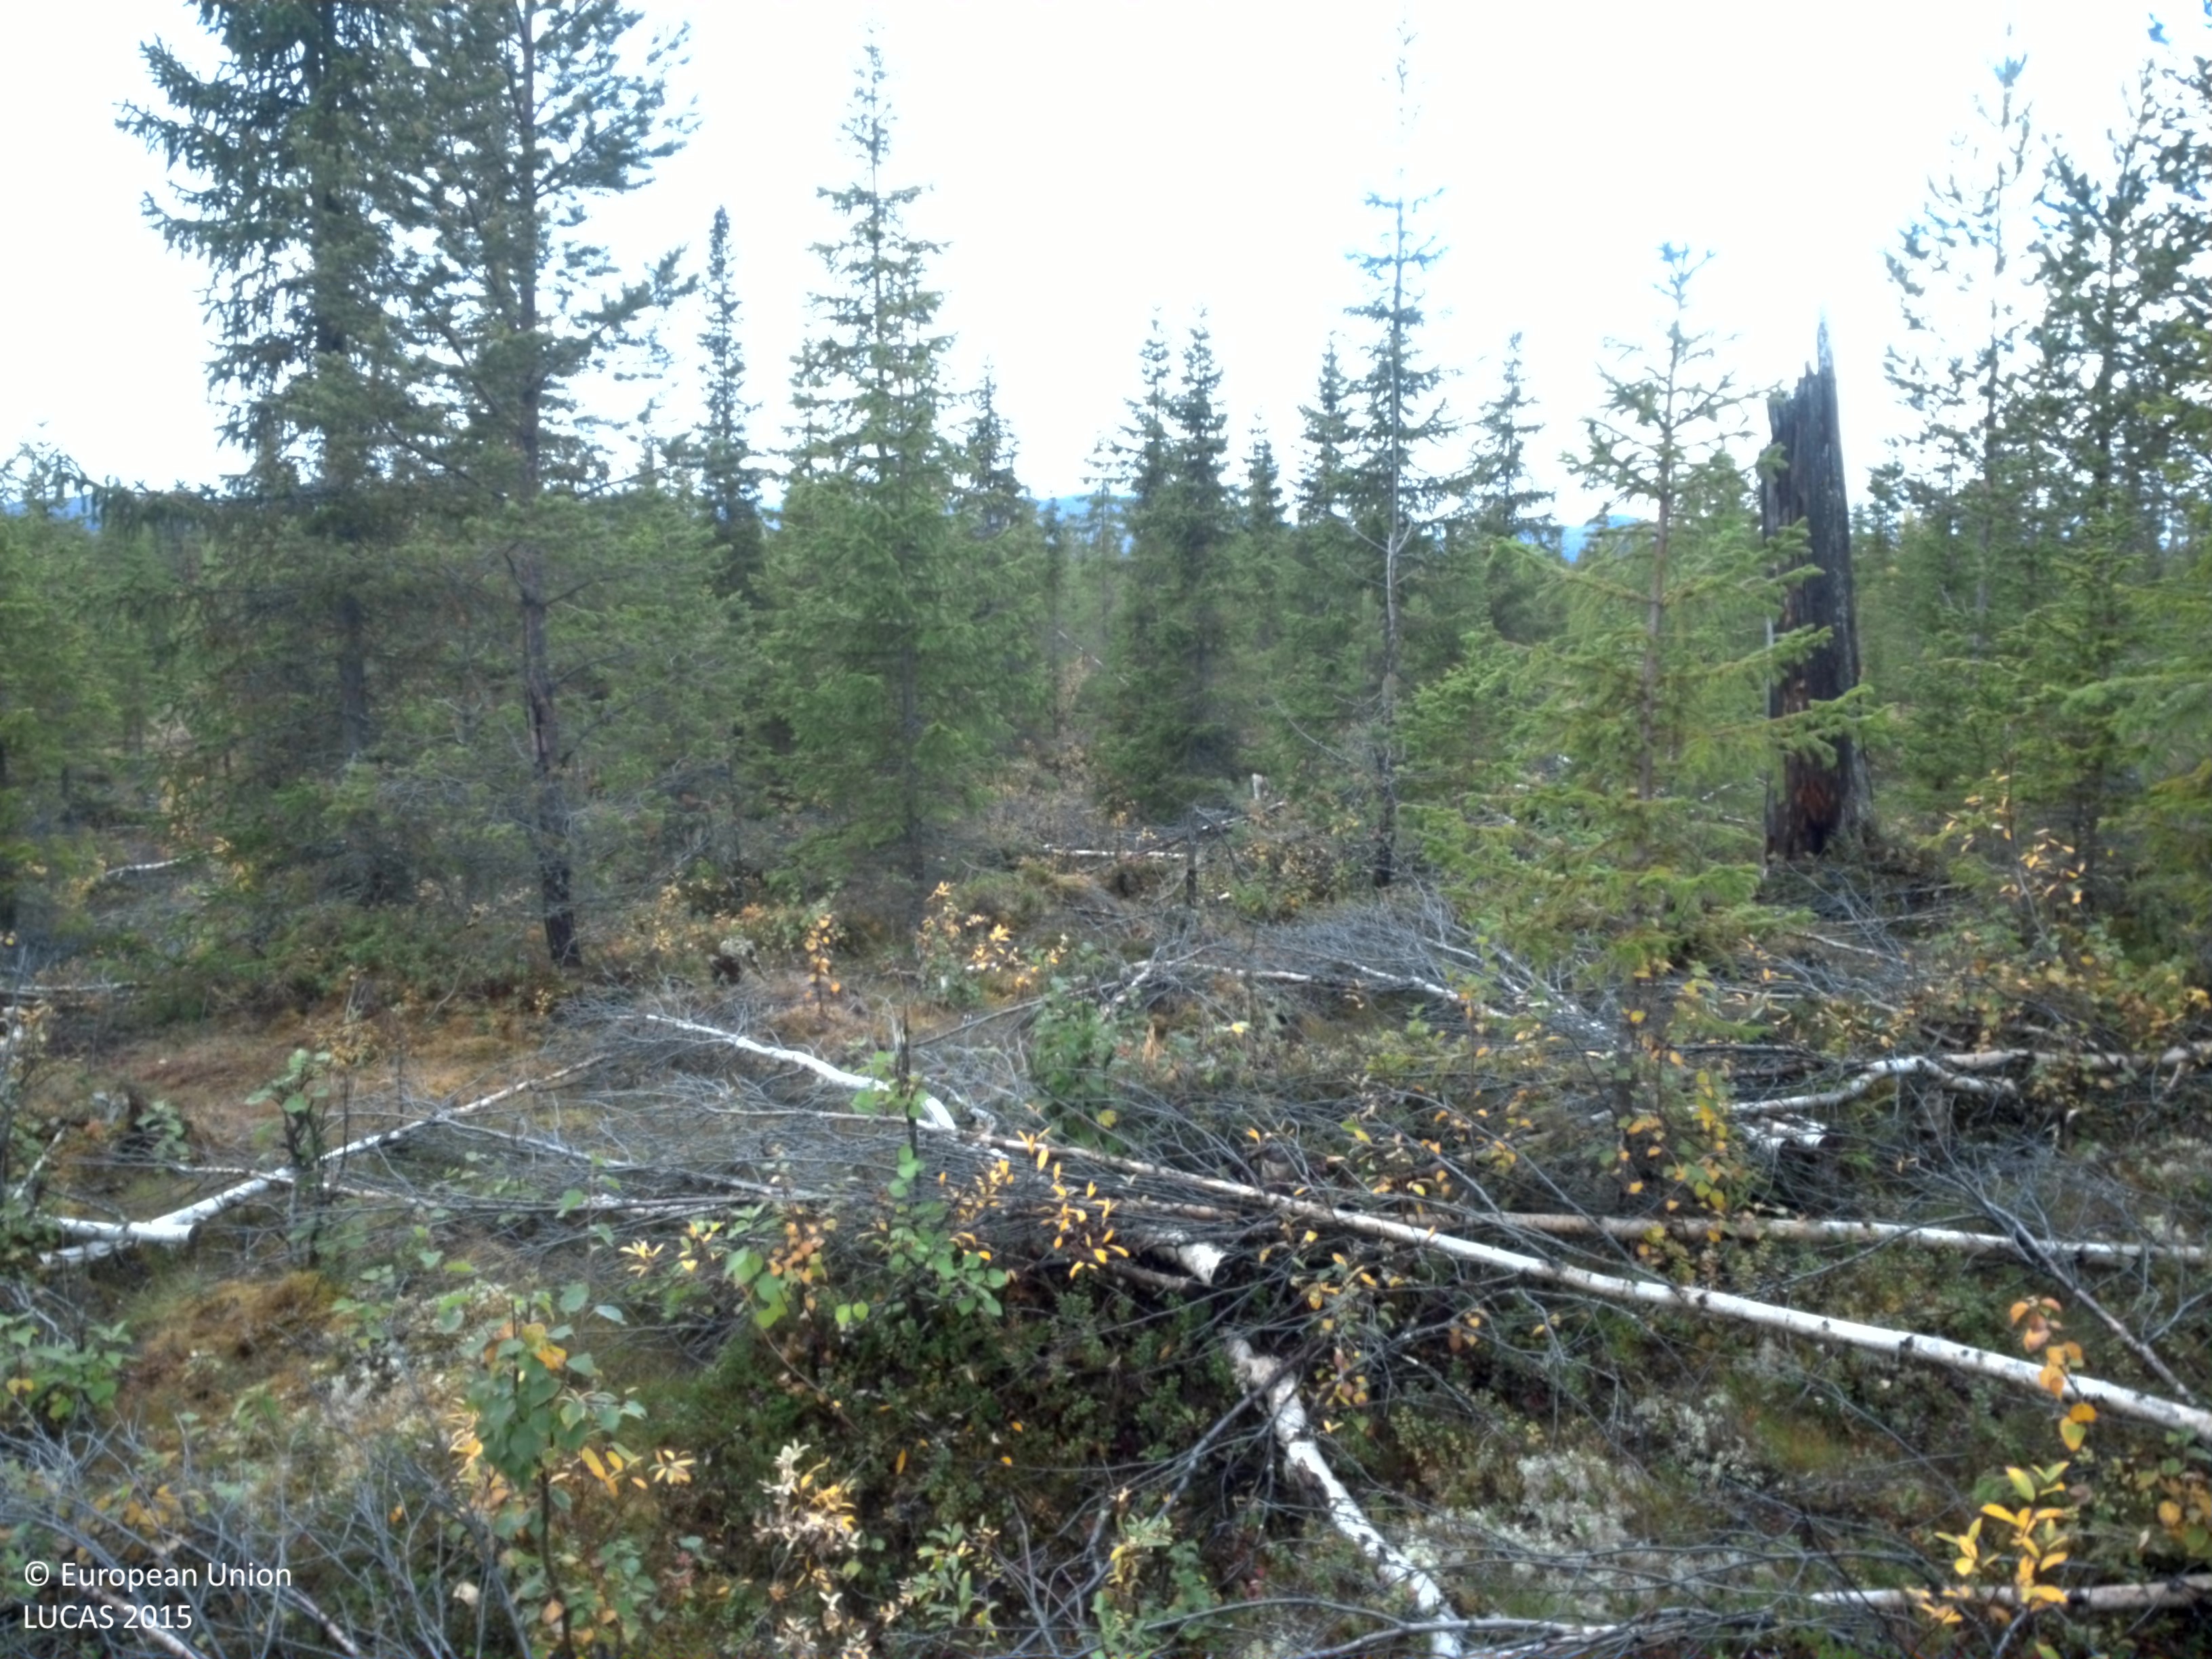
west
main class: Woodland
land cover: Spruce dominated coniferous woodland
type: boreal forest
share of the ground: 10 - 25 %
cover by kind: shrubs 40 %, lichens and mosses 20 %, herbaceous plants 15 %, coniferous forest trees 10 %
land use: Forestry
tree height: > 5 m
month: September
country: SE
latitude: 65.4030
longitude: 16.1425
